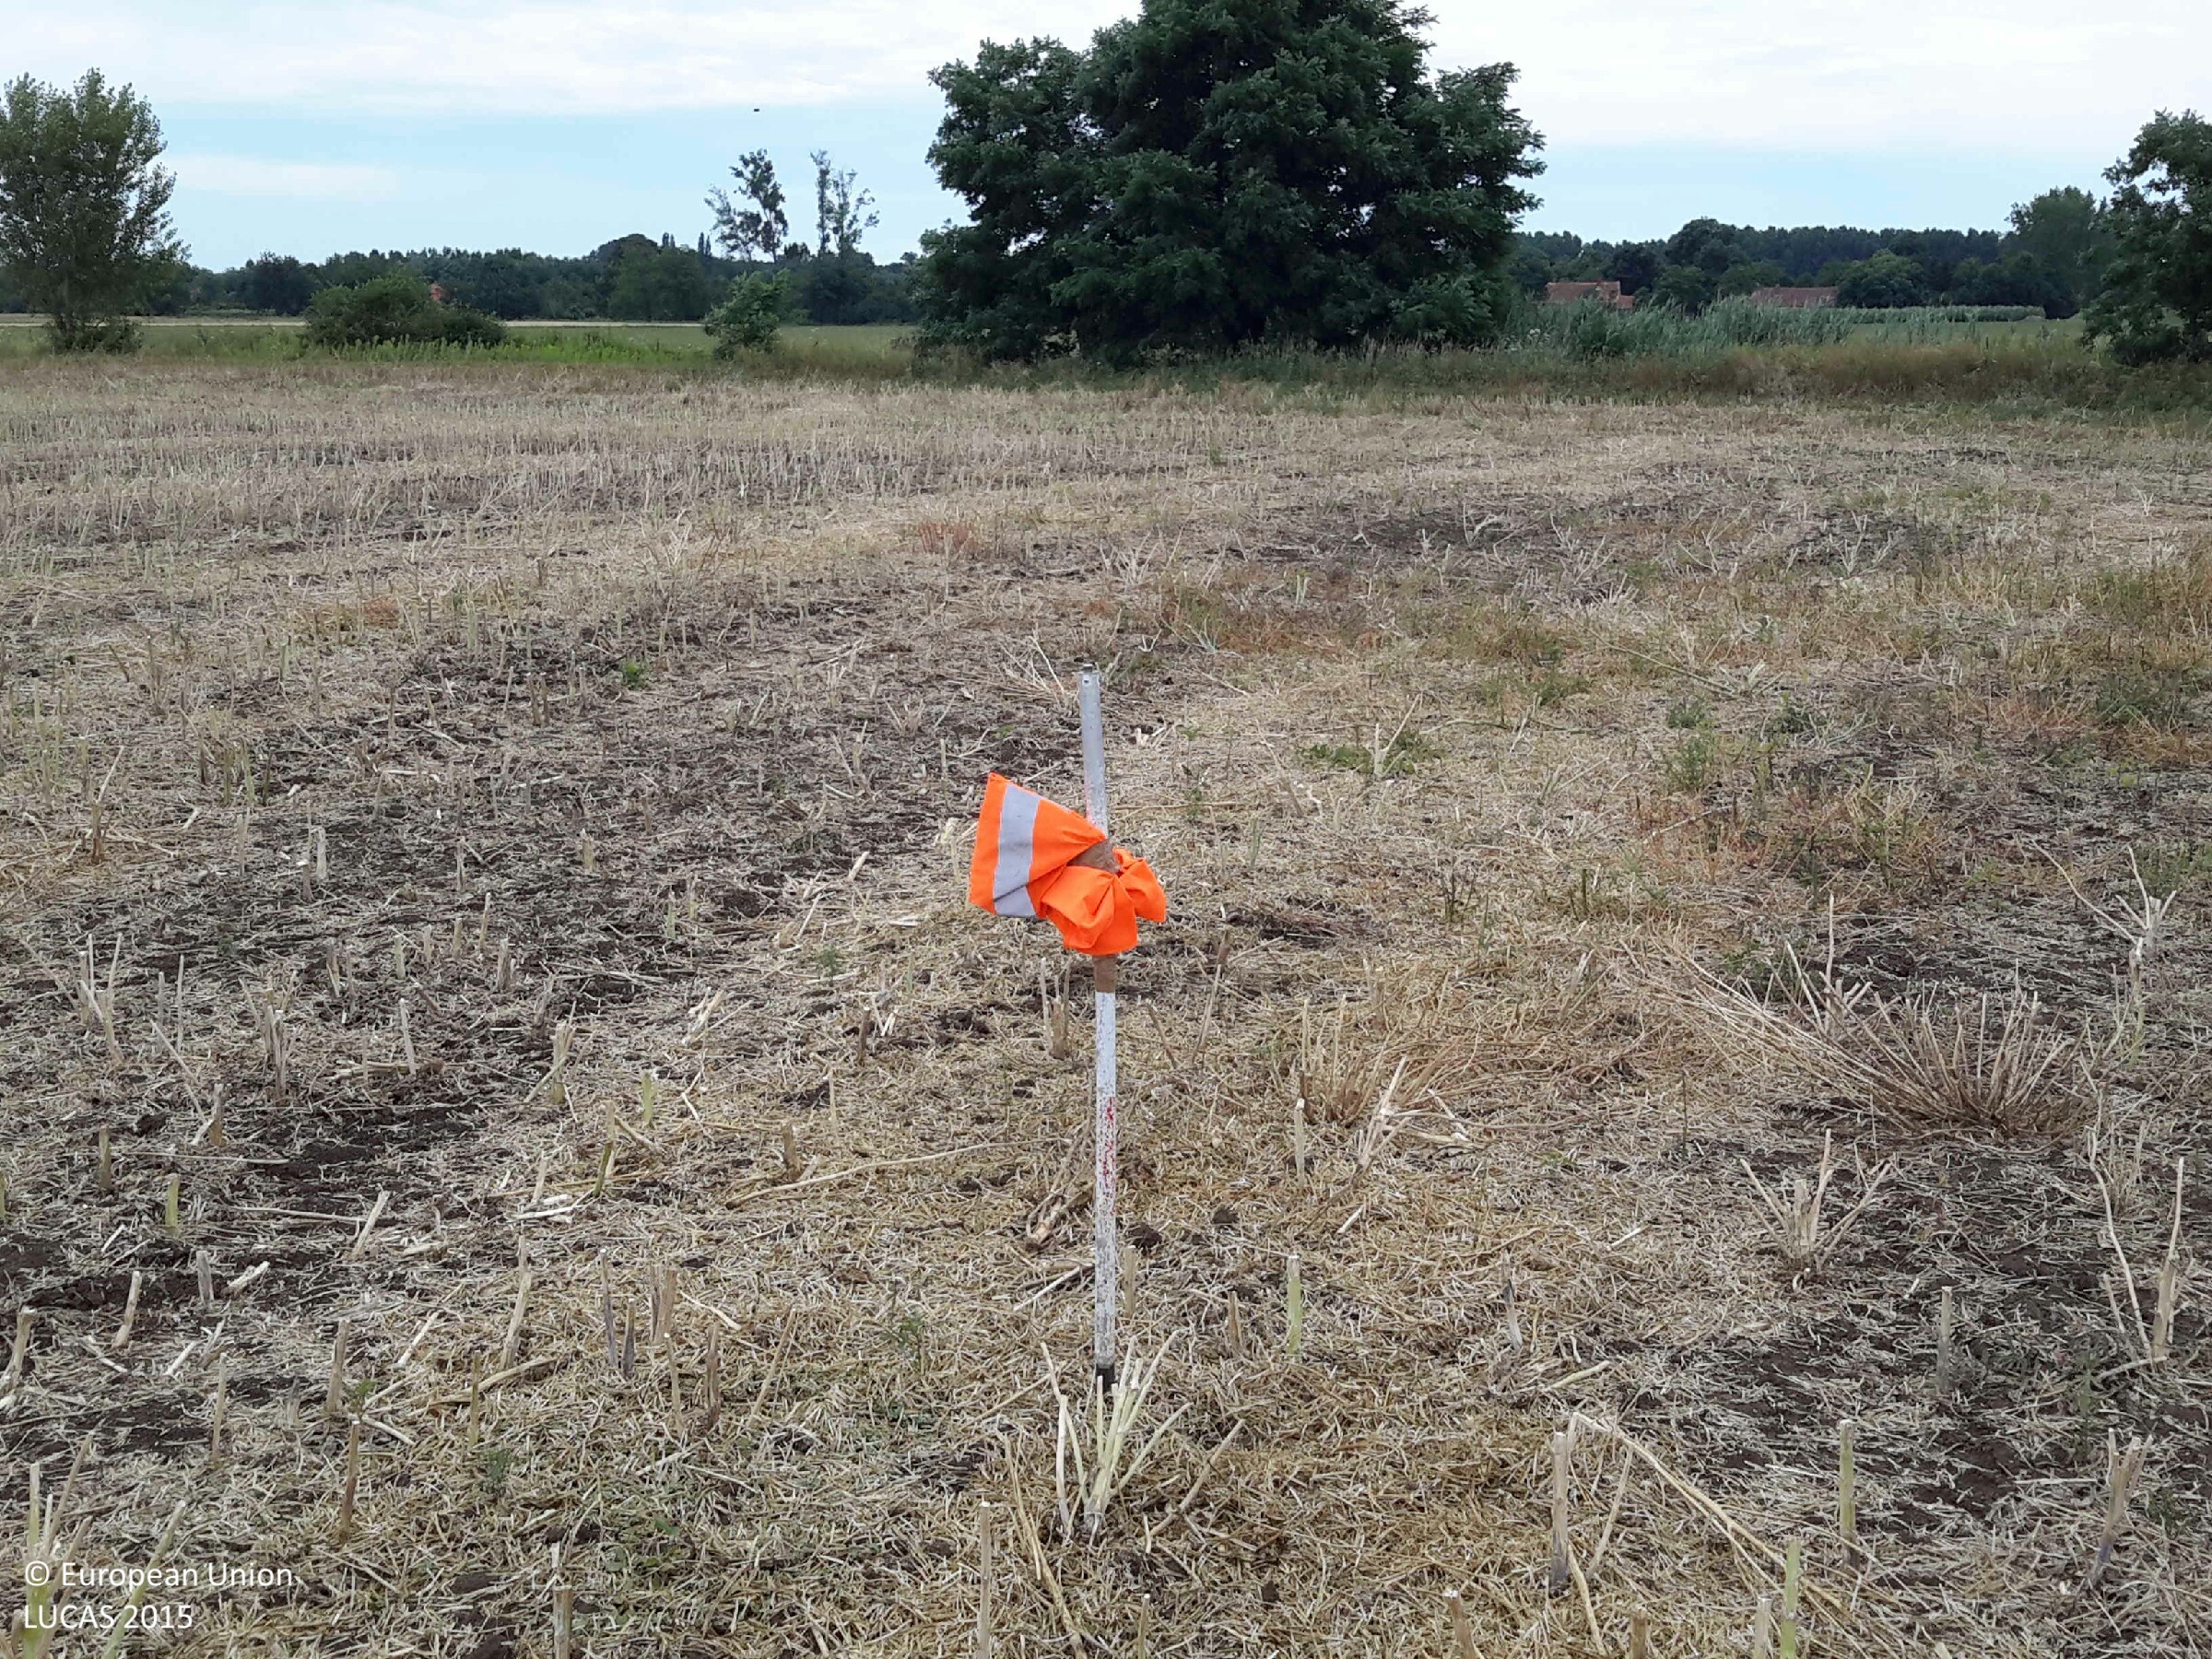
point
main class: Cropland
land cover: Rape and turnip rape
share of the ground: < 10 %
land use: Agriculture (excluding fallow land and kitchen gardens)
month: July
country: HU
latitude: 47.4437
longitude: 17.2339
